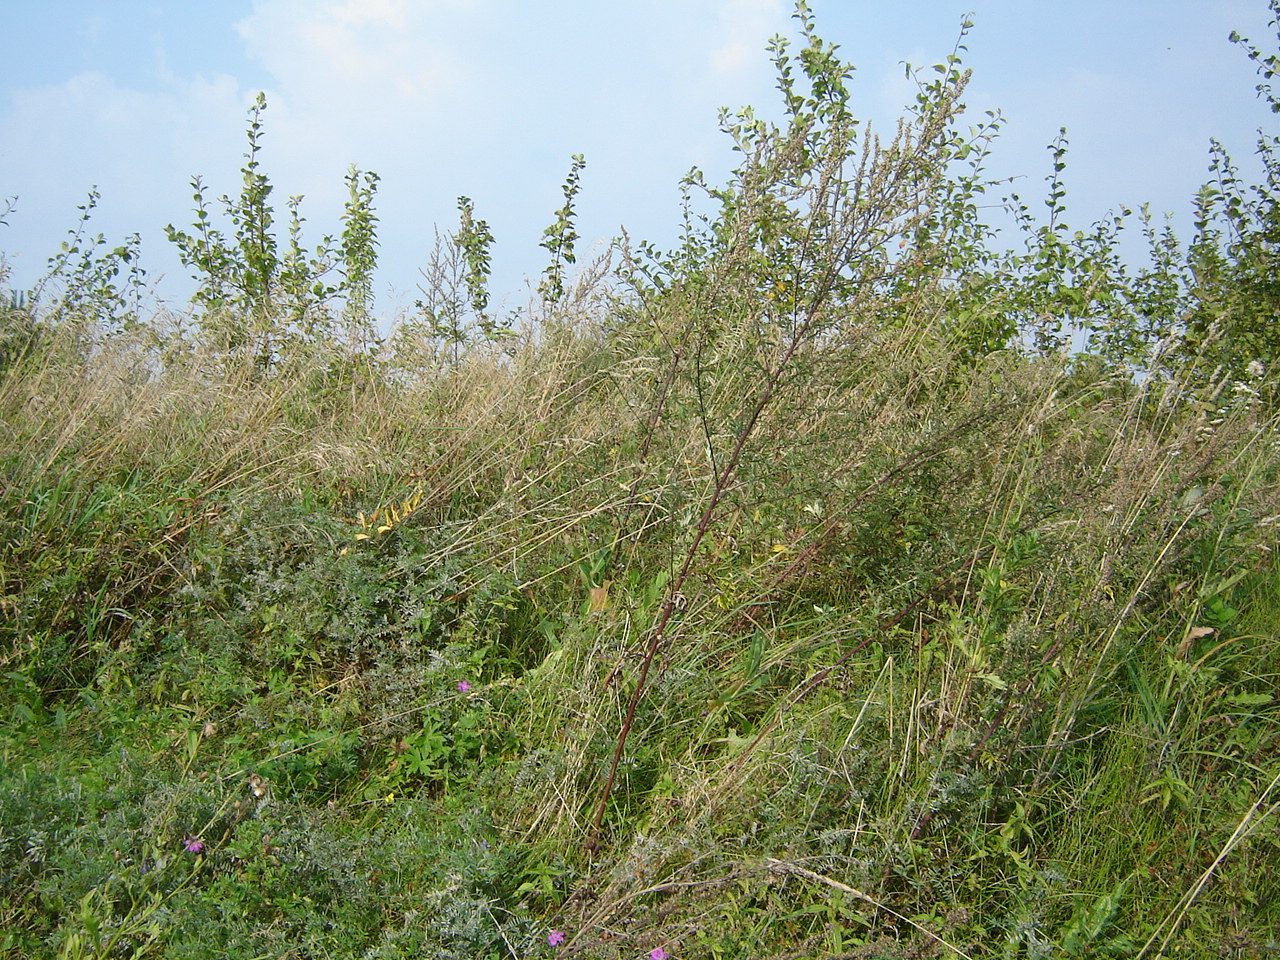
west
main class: Grassland
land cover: Spontaneously vegetated surfaces
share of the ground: > 75 %
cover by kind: herbaceous plants 100 %
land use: Semi-natural and natural areas not in use
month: September
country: LT
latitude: 54.5462
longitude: 25.1601
